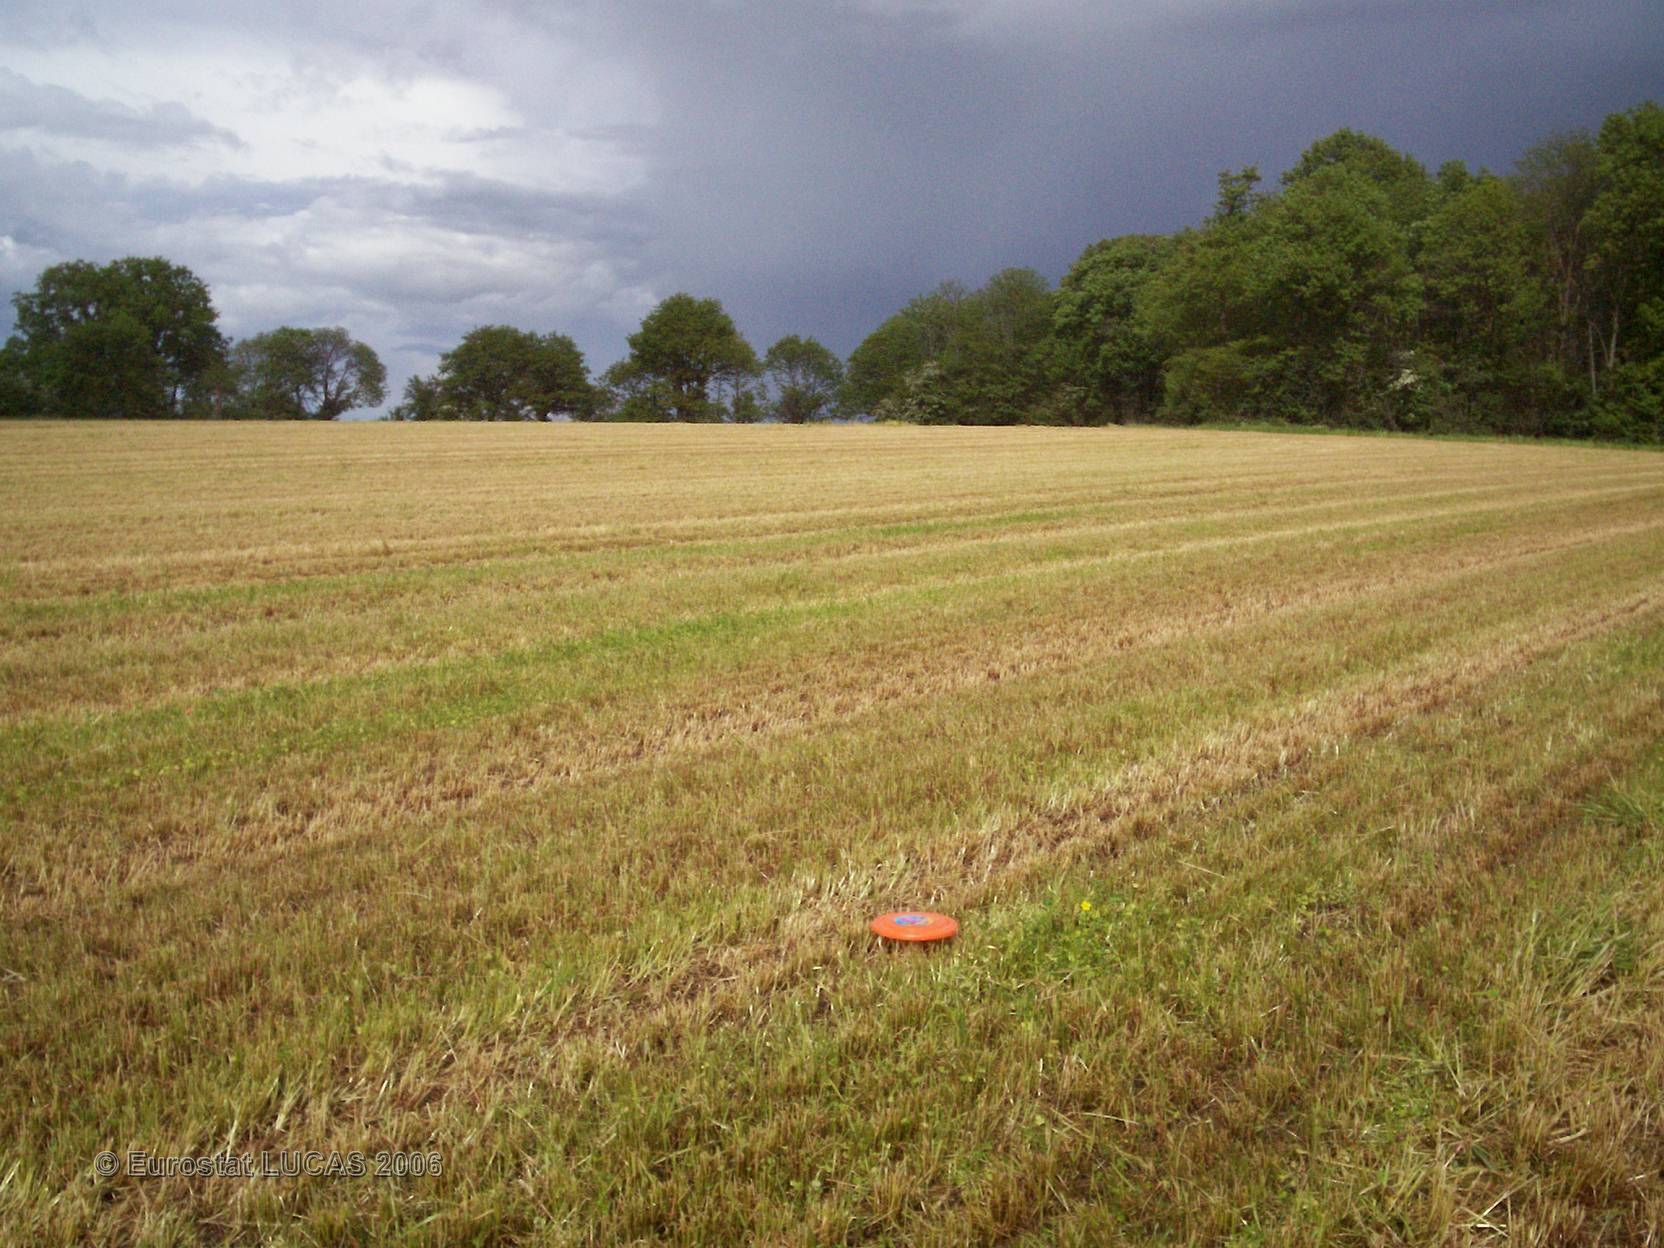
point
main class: Grassland
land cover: Grassland without tree/shrub cover
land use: Agriculture (excluding fallow land and kitchen gardens)
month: May
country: FR
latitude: 46.6173
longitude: -0.2756
